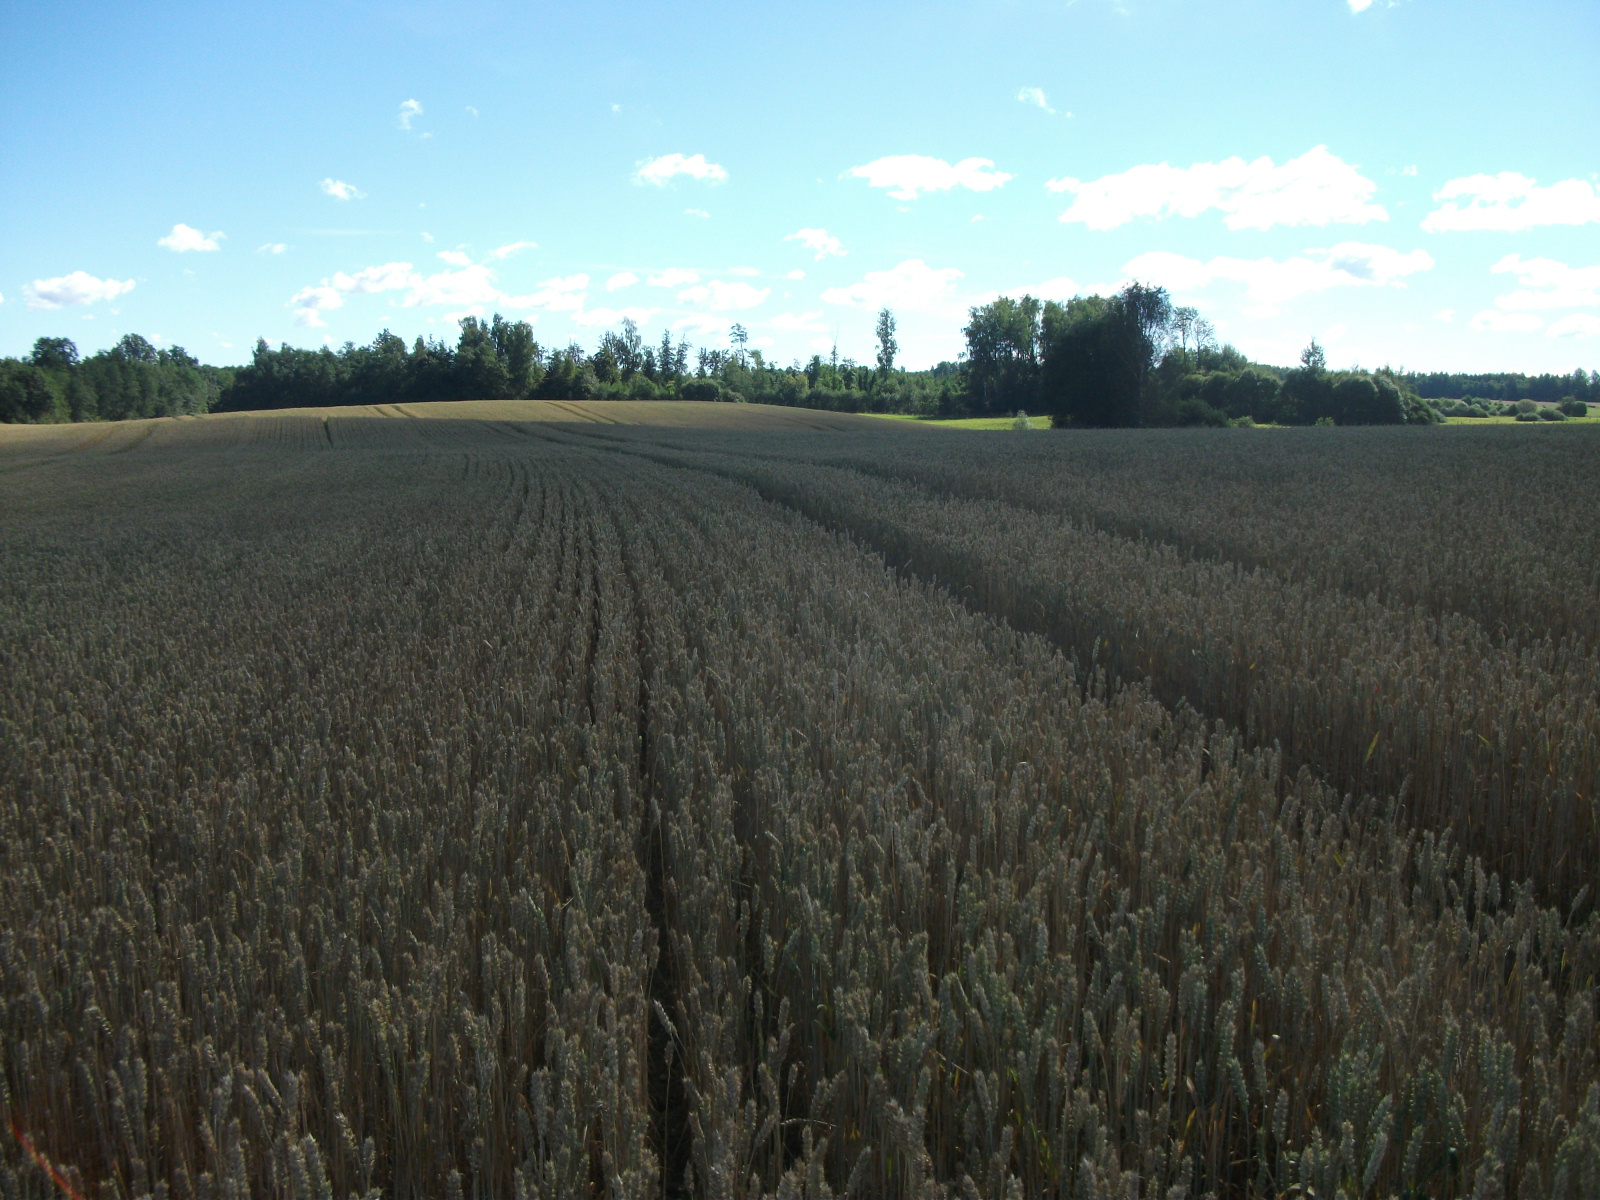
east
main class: Cropland
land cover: Common wheat
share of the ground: > 75 %
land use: Agriculture (excluding fallow land and kitchen gardens)
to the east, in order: Common wheat
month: August
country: LV
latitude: 56.6994
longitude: 26.2924
